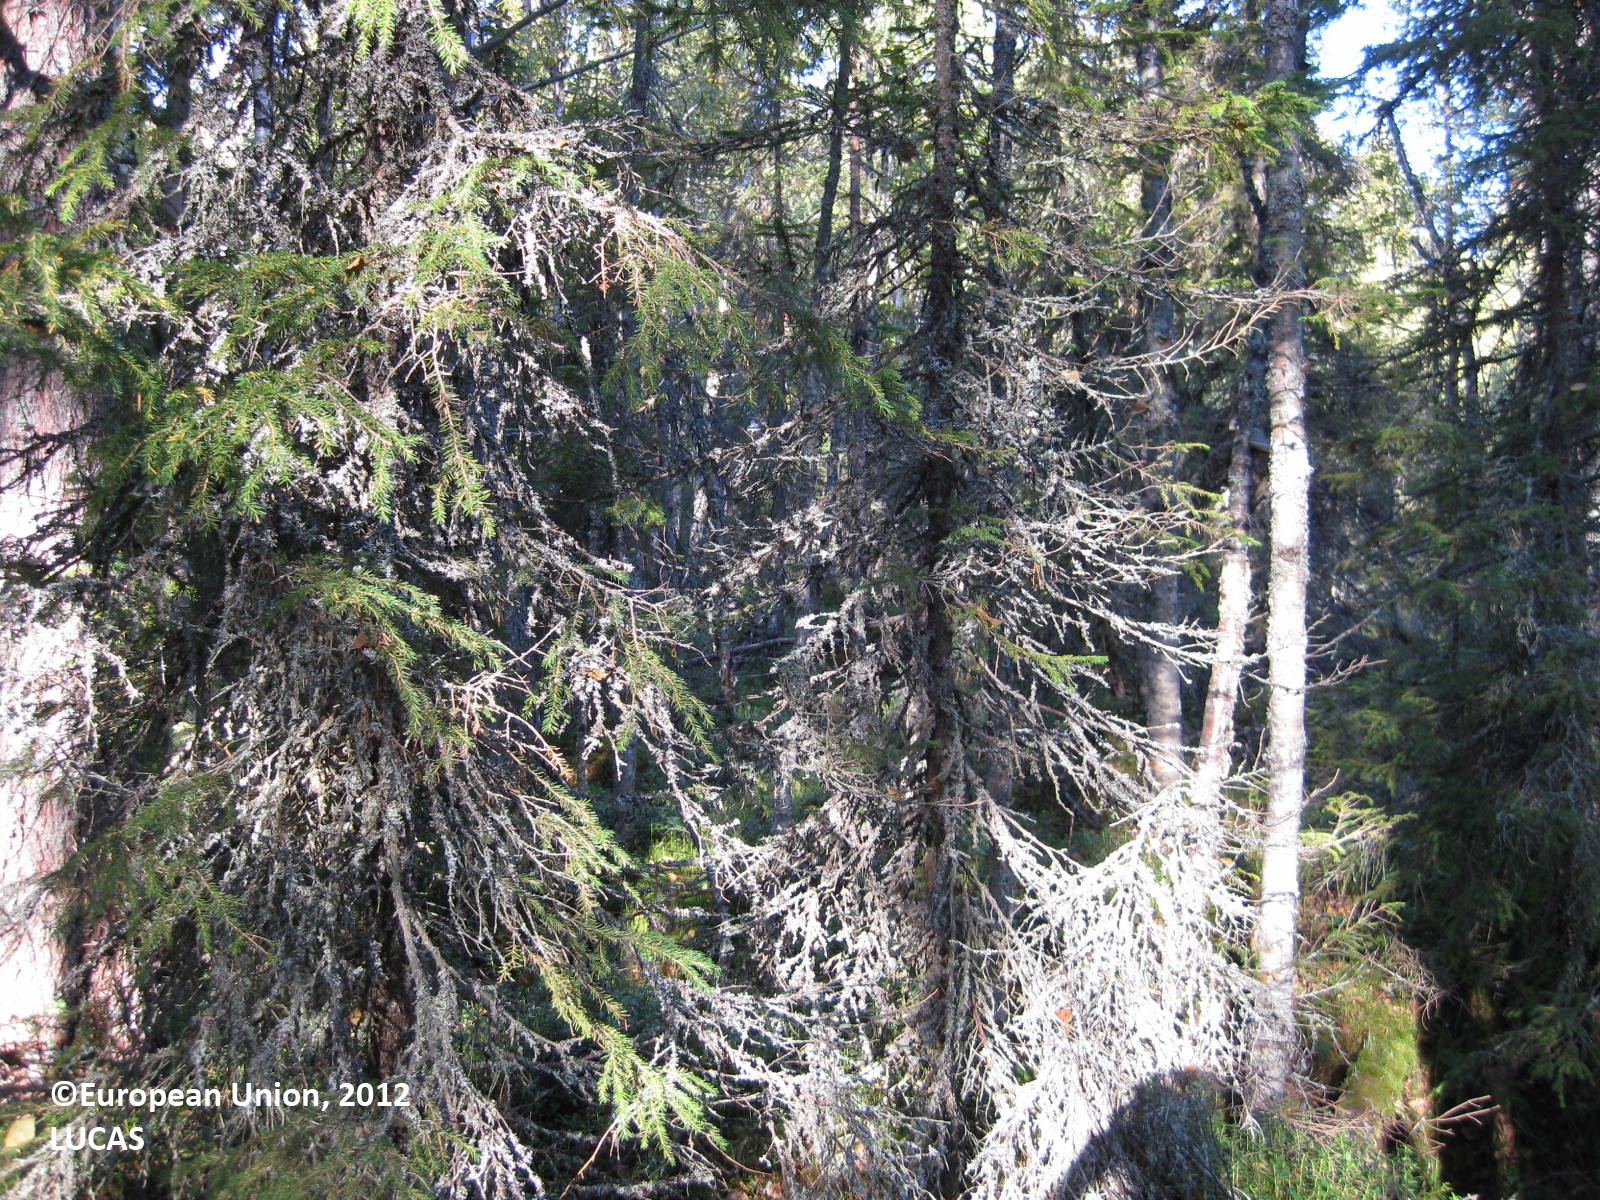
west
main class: Woodland
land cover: Other mixed woodland
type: boreal forest
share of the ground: > 75 %
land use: Forestry
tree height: > 5 m
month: August
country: FI
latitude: 66.0520
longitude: 29.5542
